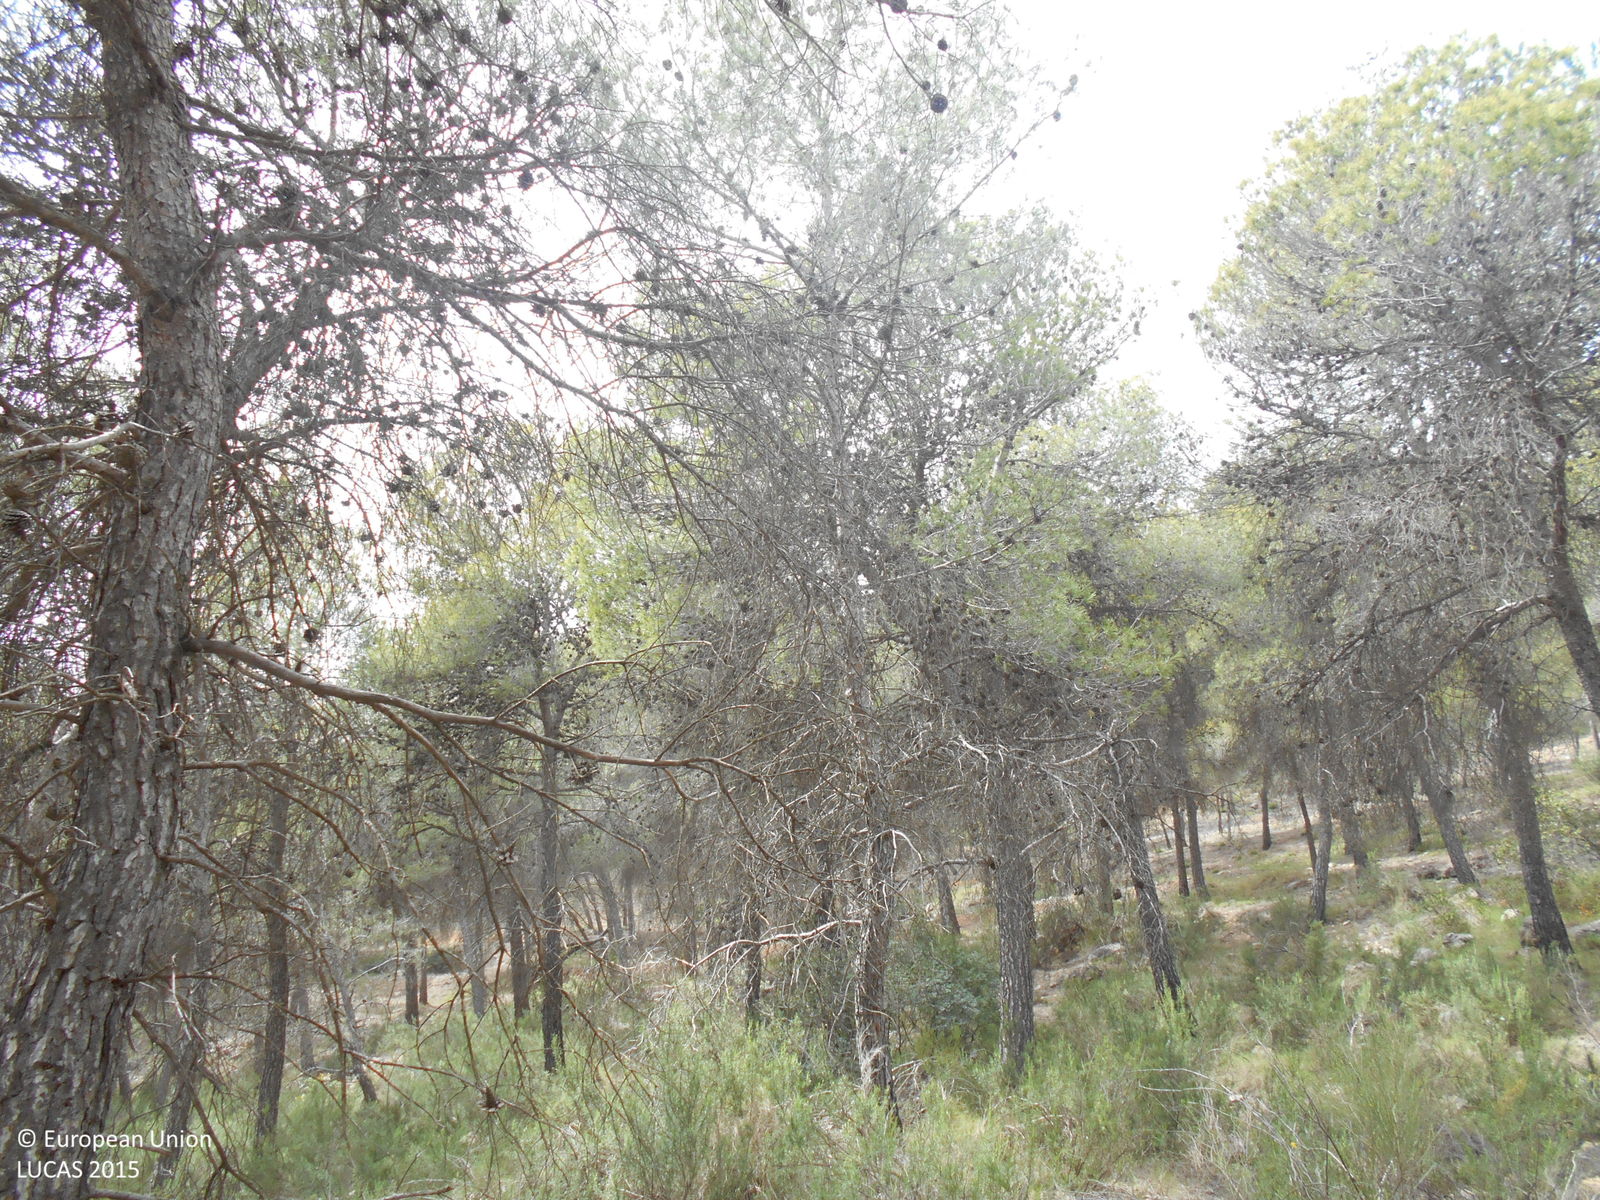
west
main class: Woodland
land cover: Pine dominated coniferous woodland
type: coniferous forest of the mediterranean region
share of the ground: > 75 %
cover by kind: coniferous forest trees 75 %, shrubs 20 %, unconsolidated bare surface 5 %
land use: Semi-natural and natural areas not in use
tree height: > 5 m
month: April
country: ES
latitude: 37.8708
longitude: -1.5000
